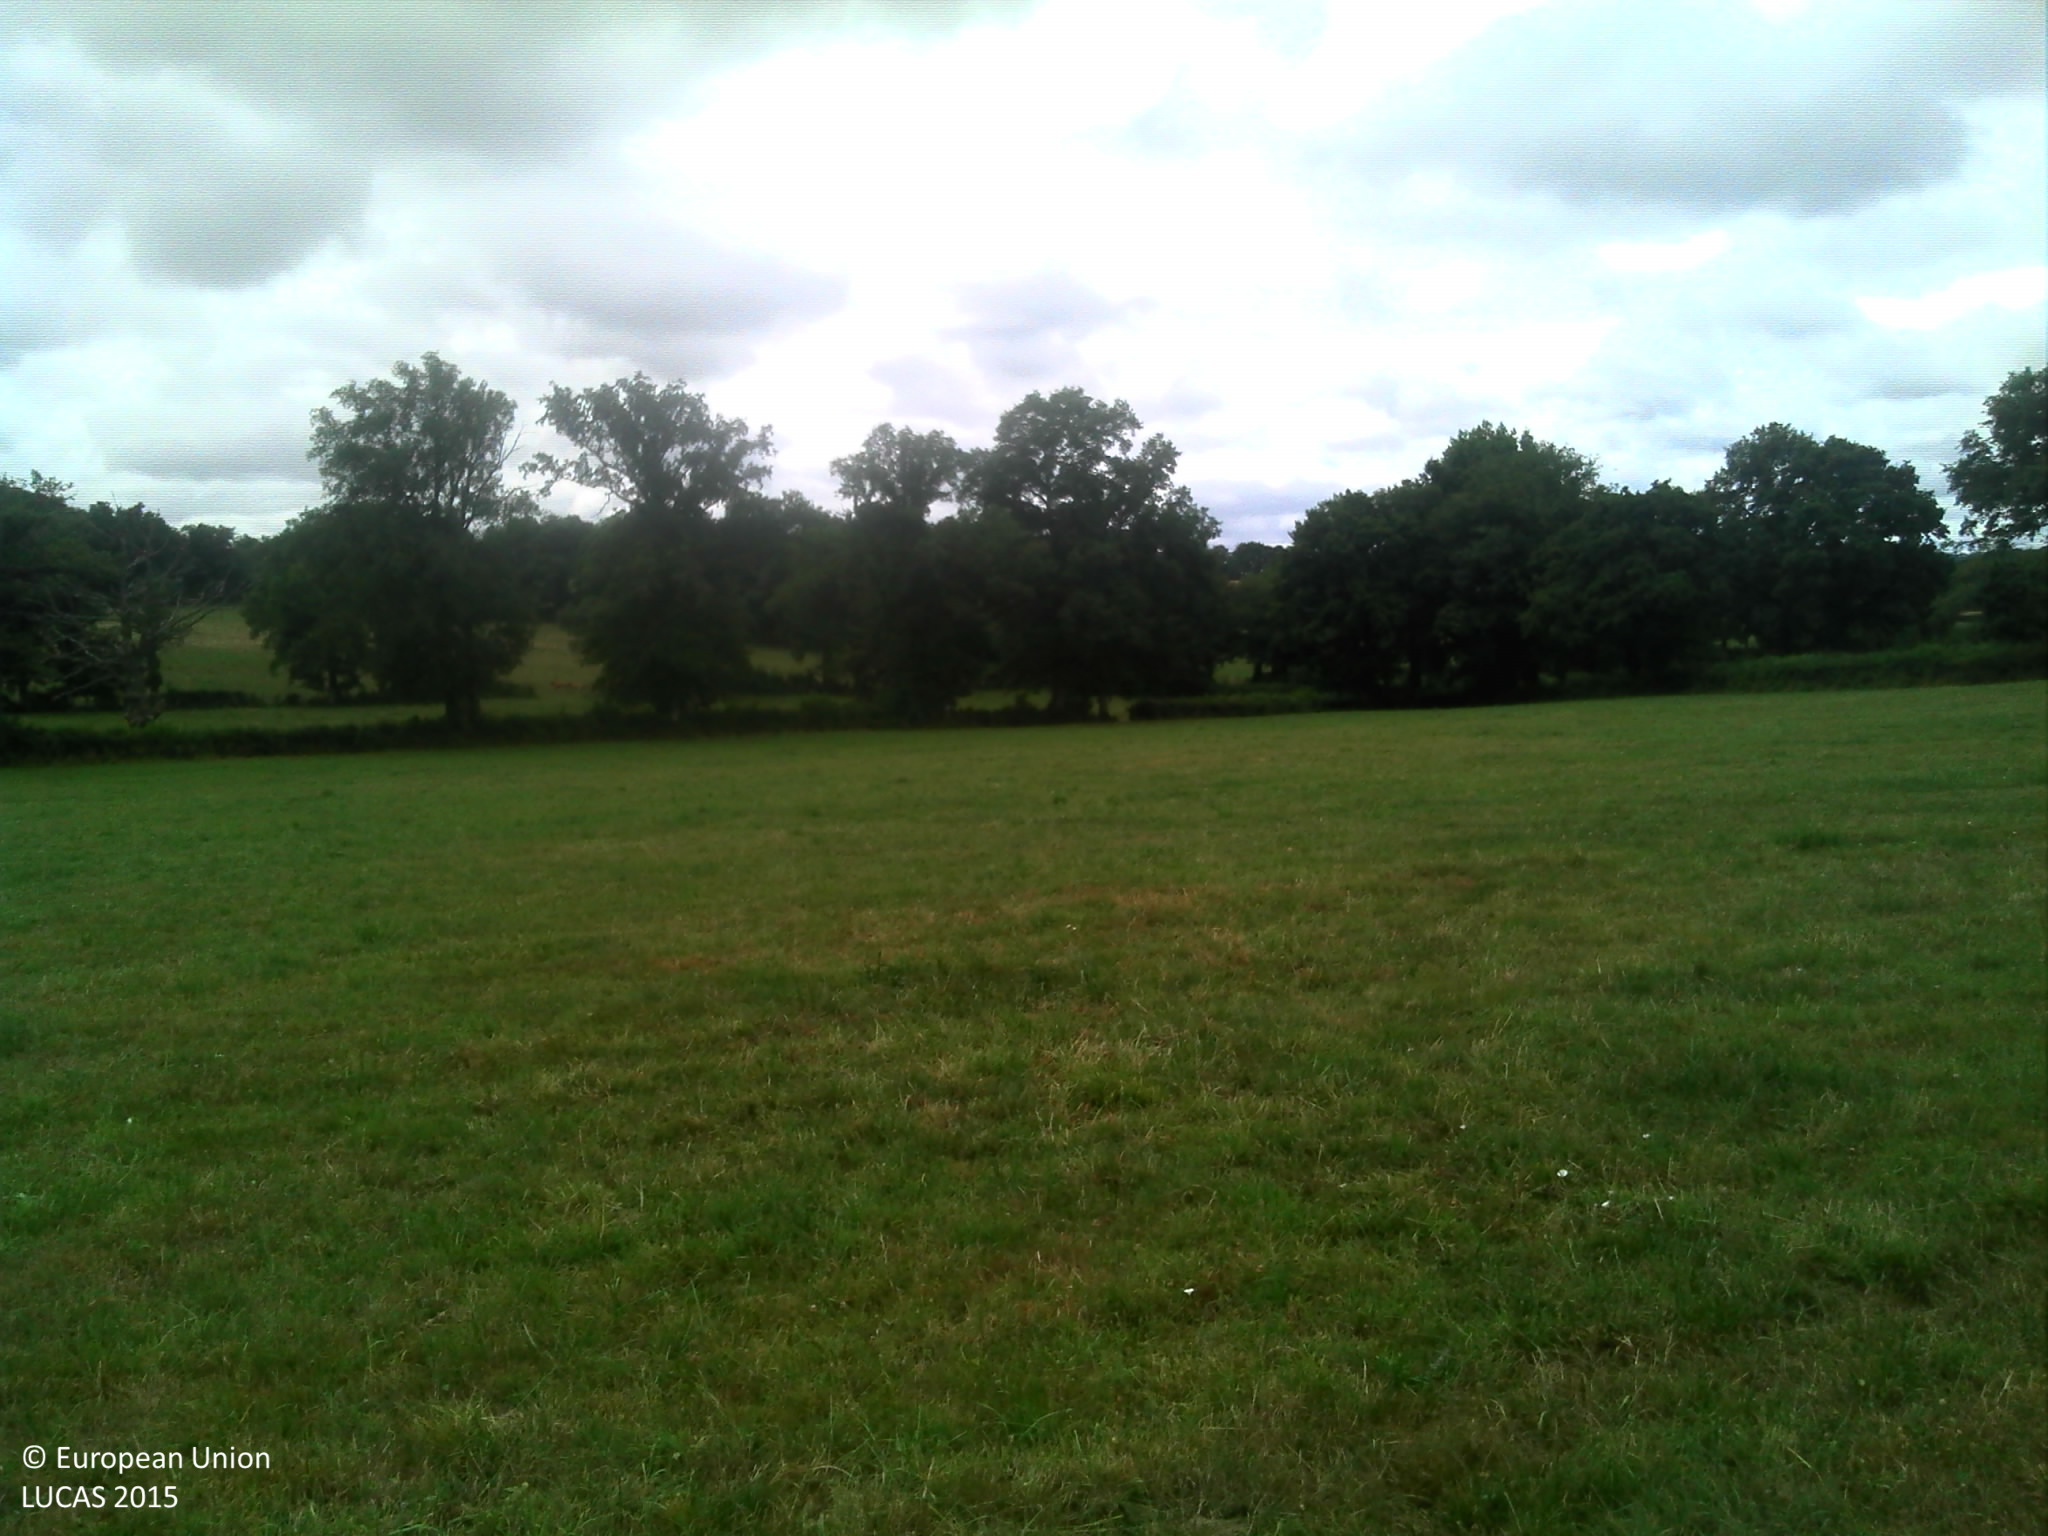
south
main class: Grassland
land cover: Grassland without tree/shrub cover
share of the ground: > 75 %
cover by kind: herbaceous plants 100 %
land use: Agriculture (excluding fallow land and kitchen gardens)
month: July
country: FR
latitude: 46.3766
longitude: 1.5267
